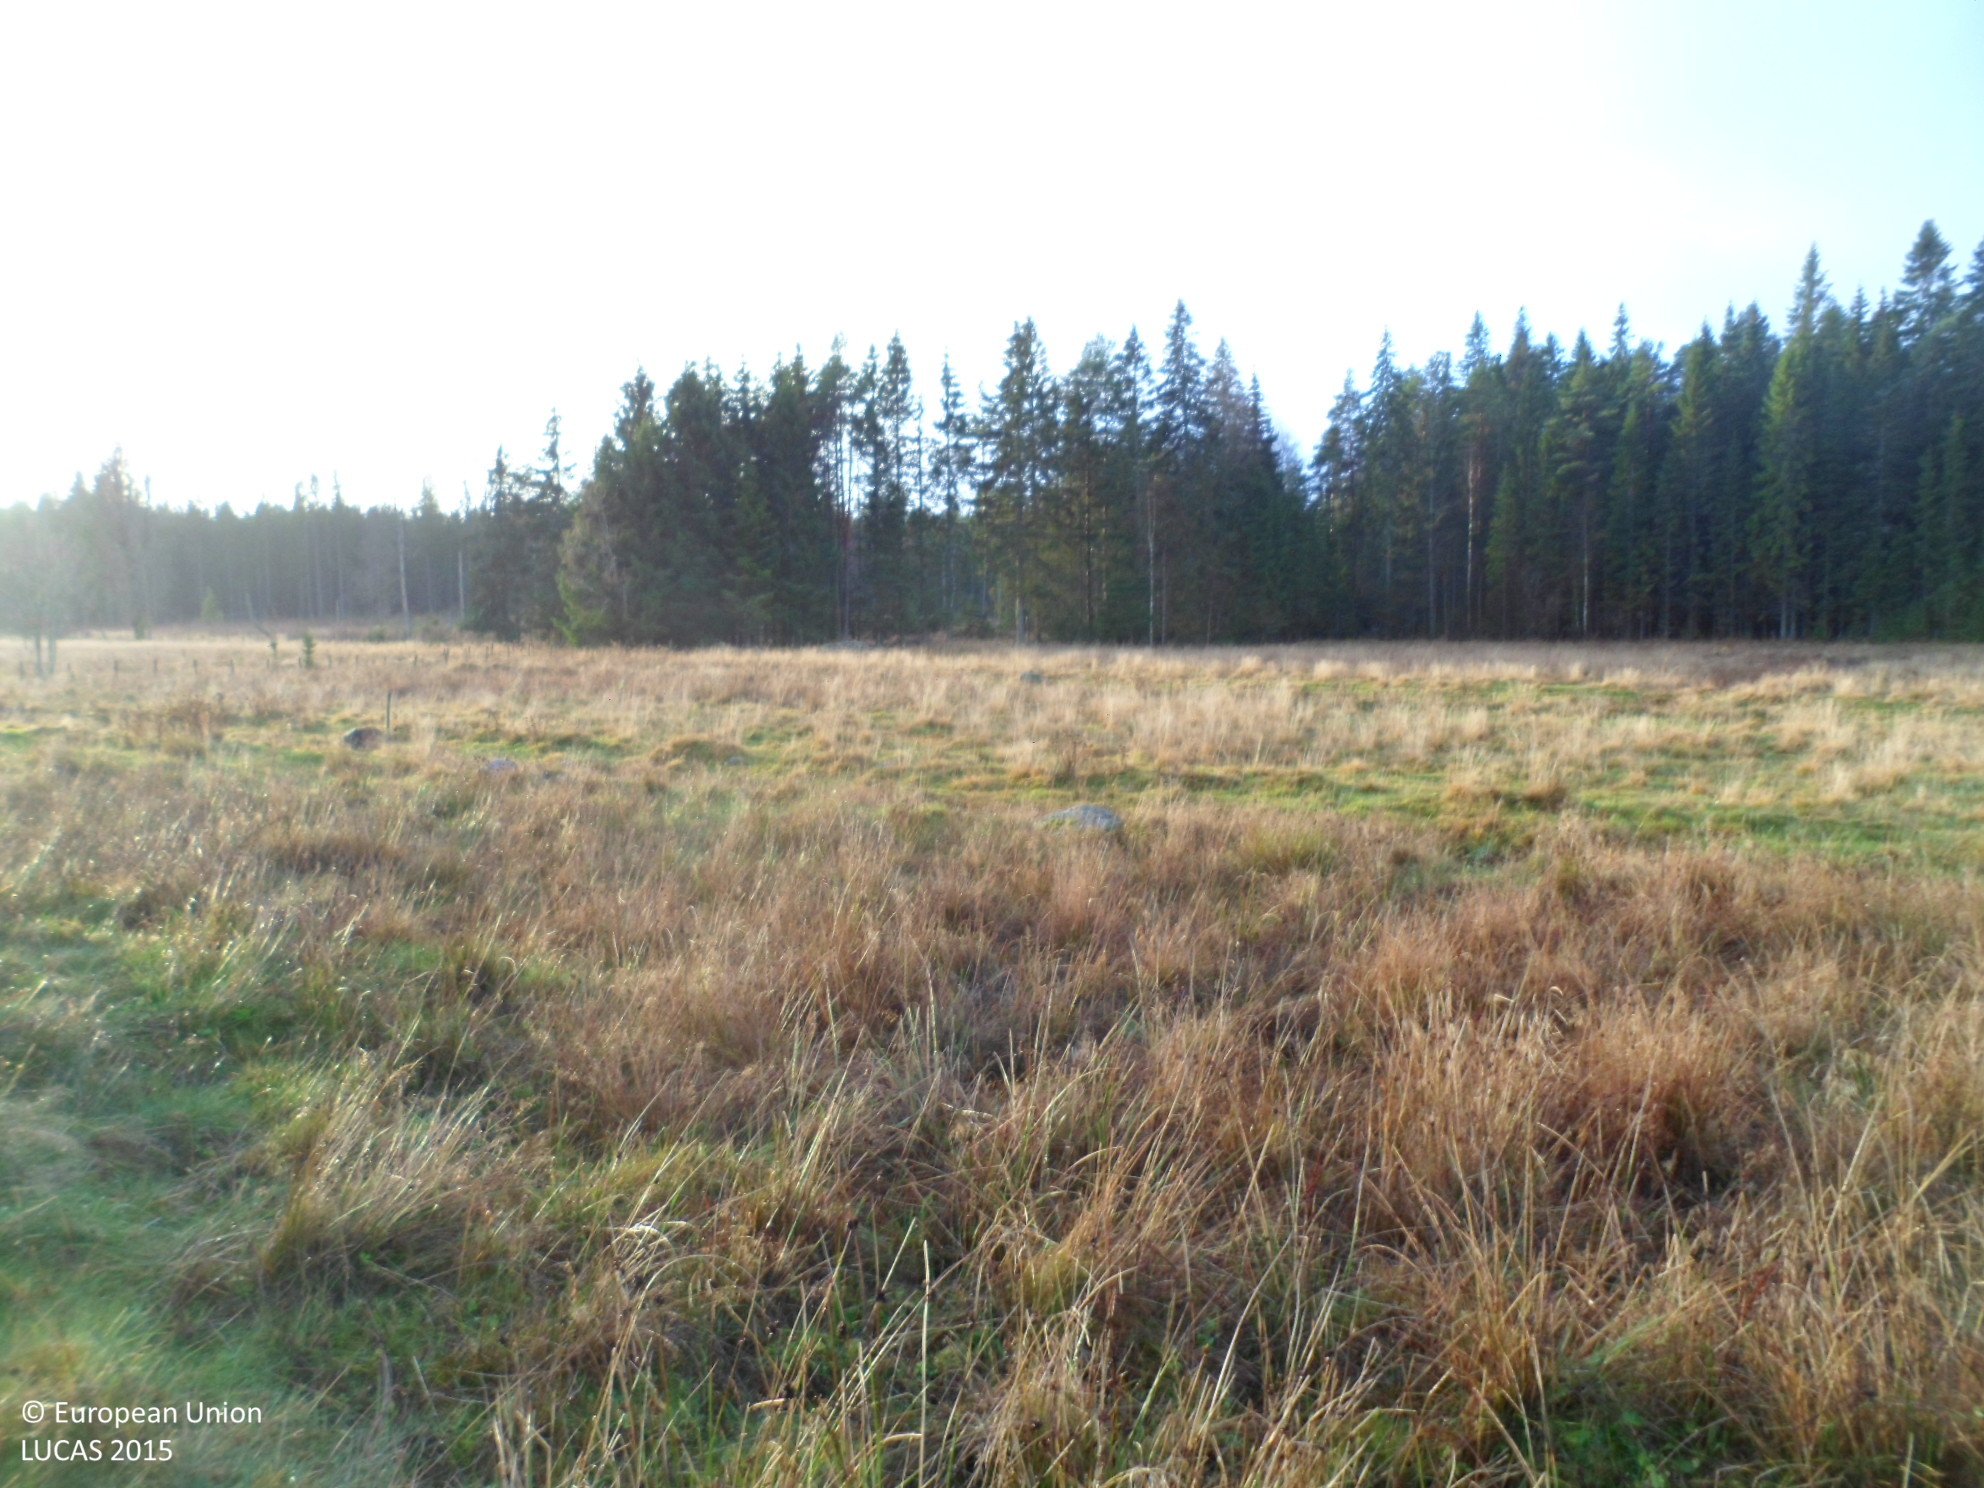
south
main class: Grassland
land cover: Grassland without tree/shrub cover
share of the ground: > 75 %
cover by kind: herbaceous plants 90 %, lichens and mosses 10 %
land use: Agriculture (excluding fallow land and kitchen gardens)
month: November
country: SE
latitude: 57.5975
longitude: 15.1662
